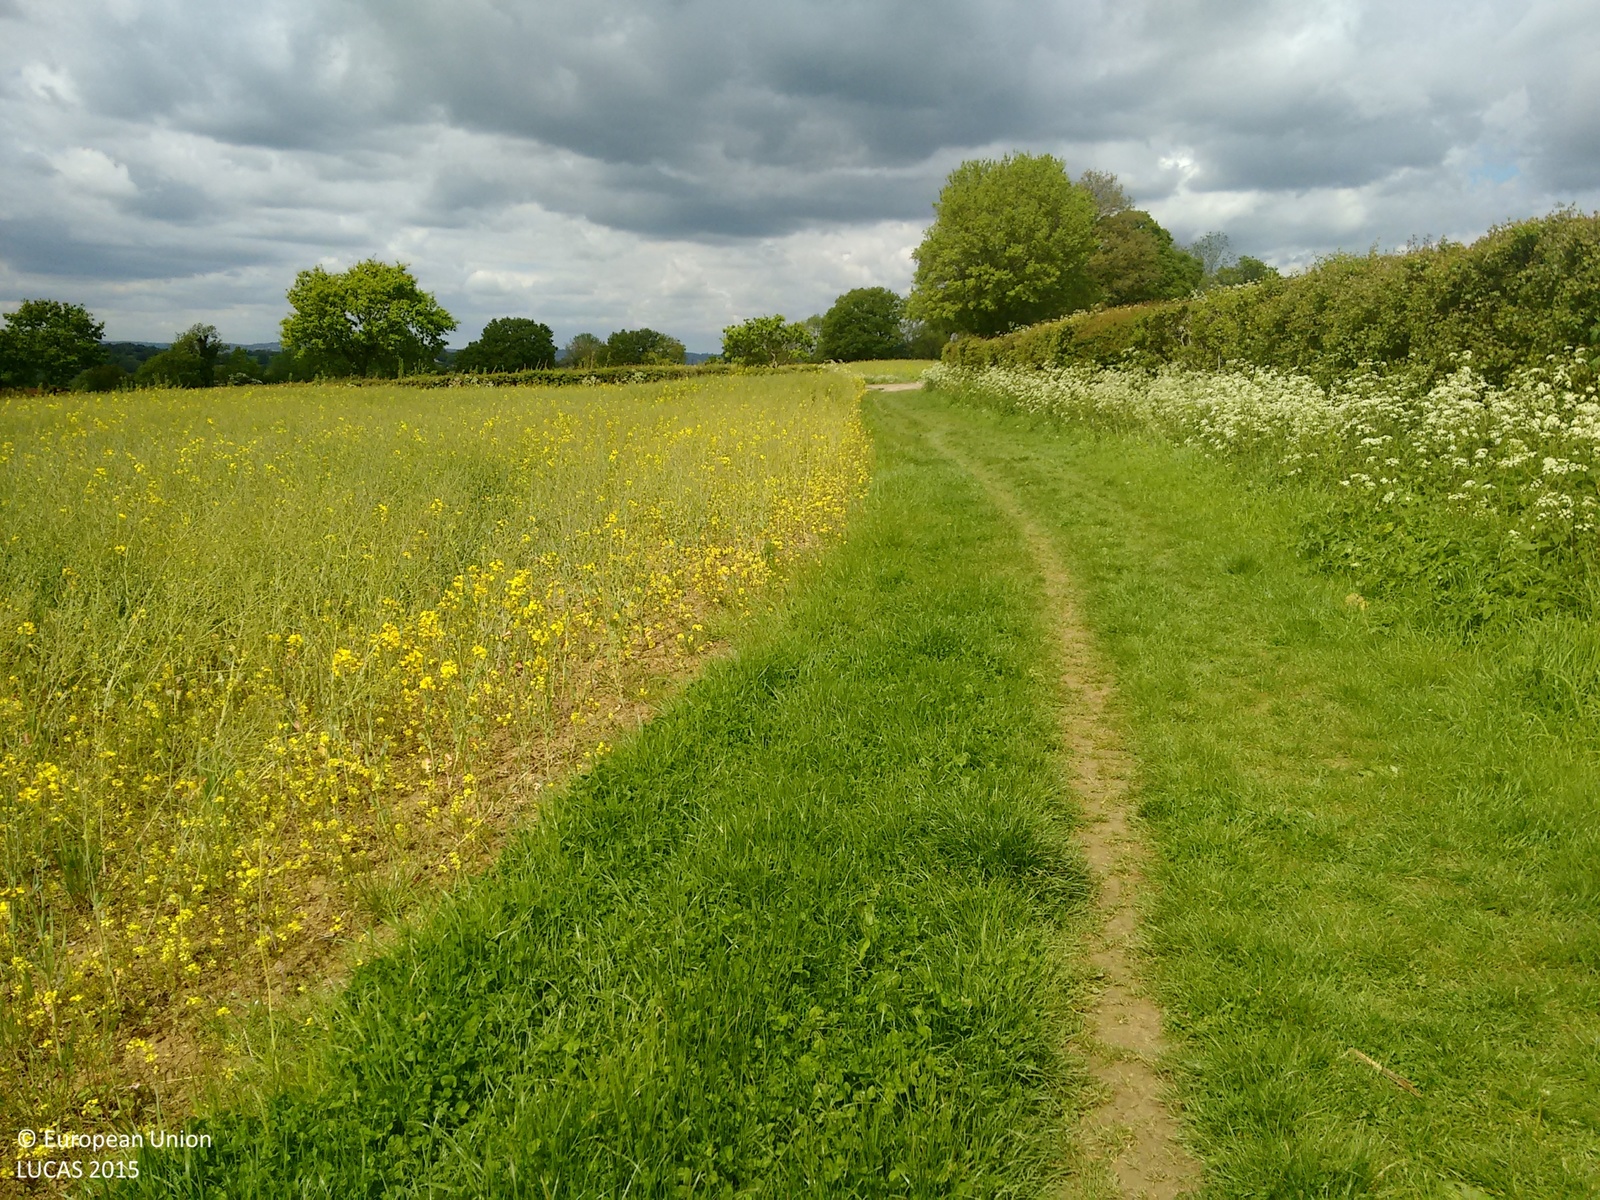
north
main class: Cropland
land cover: Rape and turnip rape
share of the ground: > 75 %
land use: Agriculture (excluding fallow land and kitchen gardens)
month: May
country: GB
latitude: 51.1361
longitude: 0.1792
